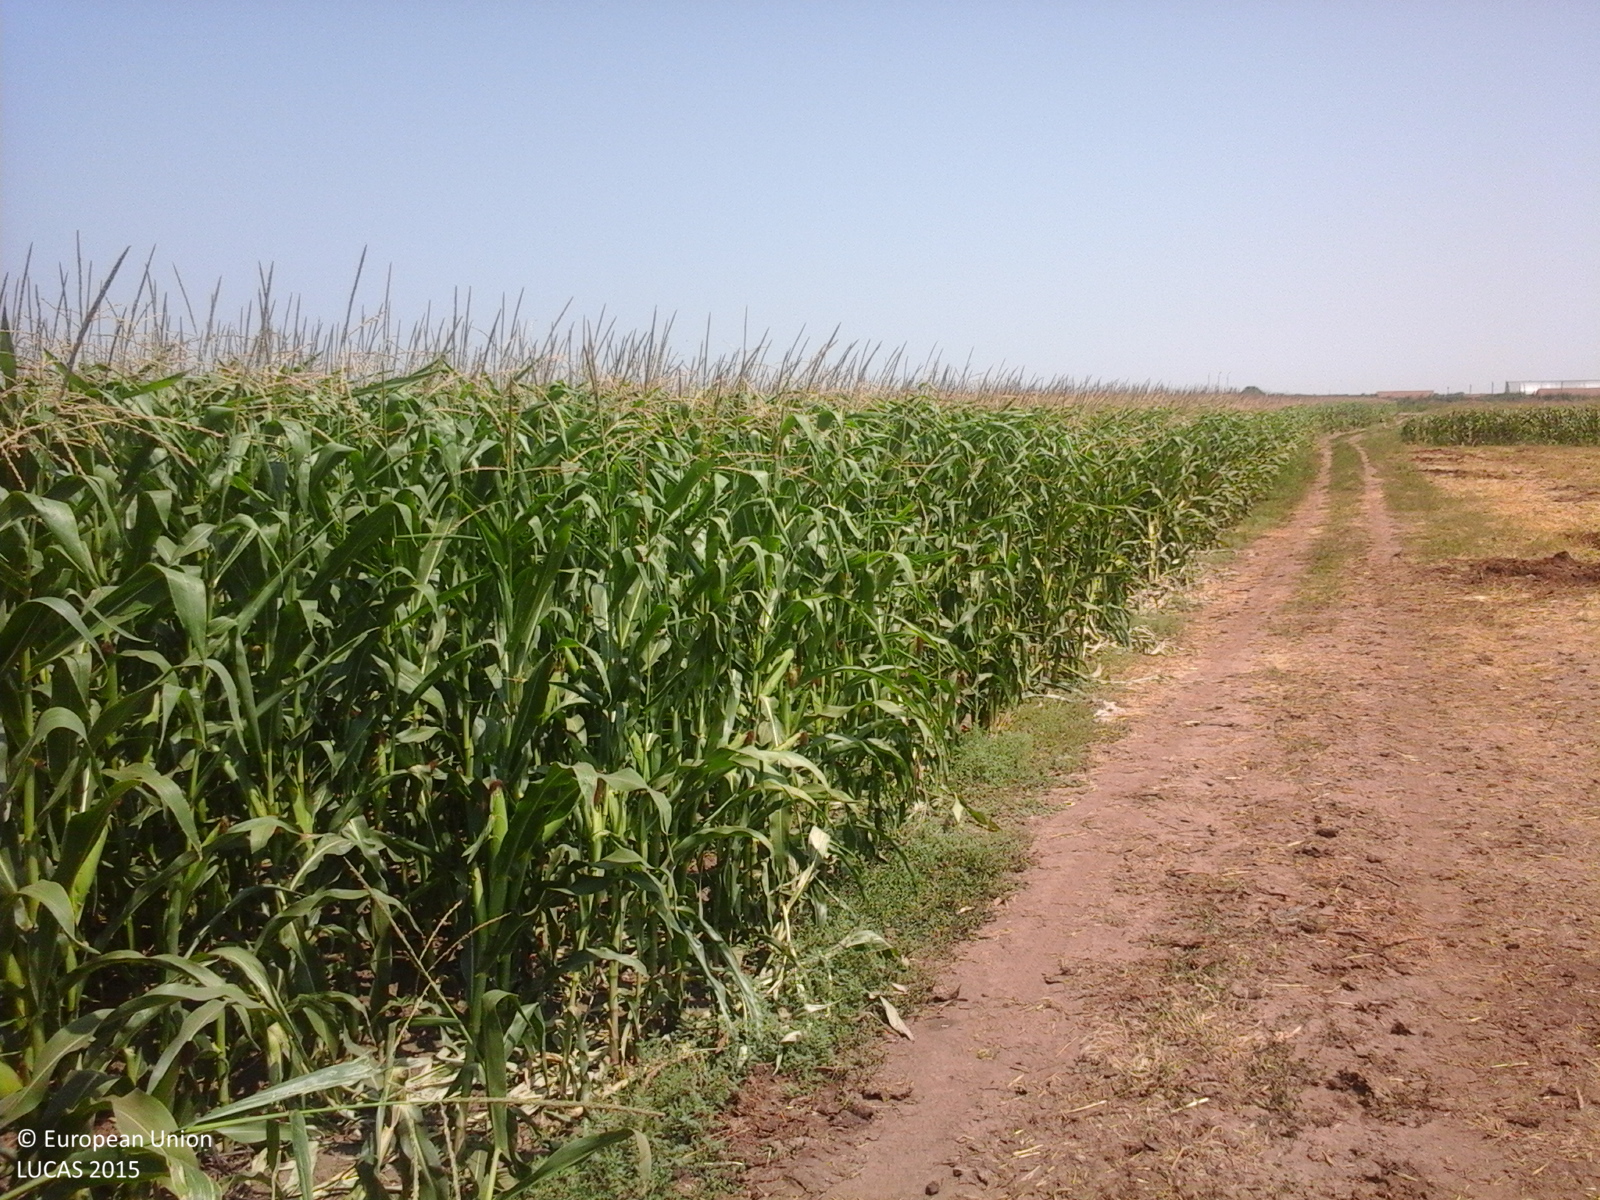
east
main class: Cropland
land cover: Maize
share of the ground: > 75 %
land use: Agriculture (excluding fallow land and kitchen gardens)
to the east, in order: Maize
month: July
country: RO
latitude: 44.7235
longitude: 27.0895
